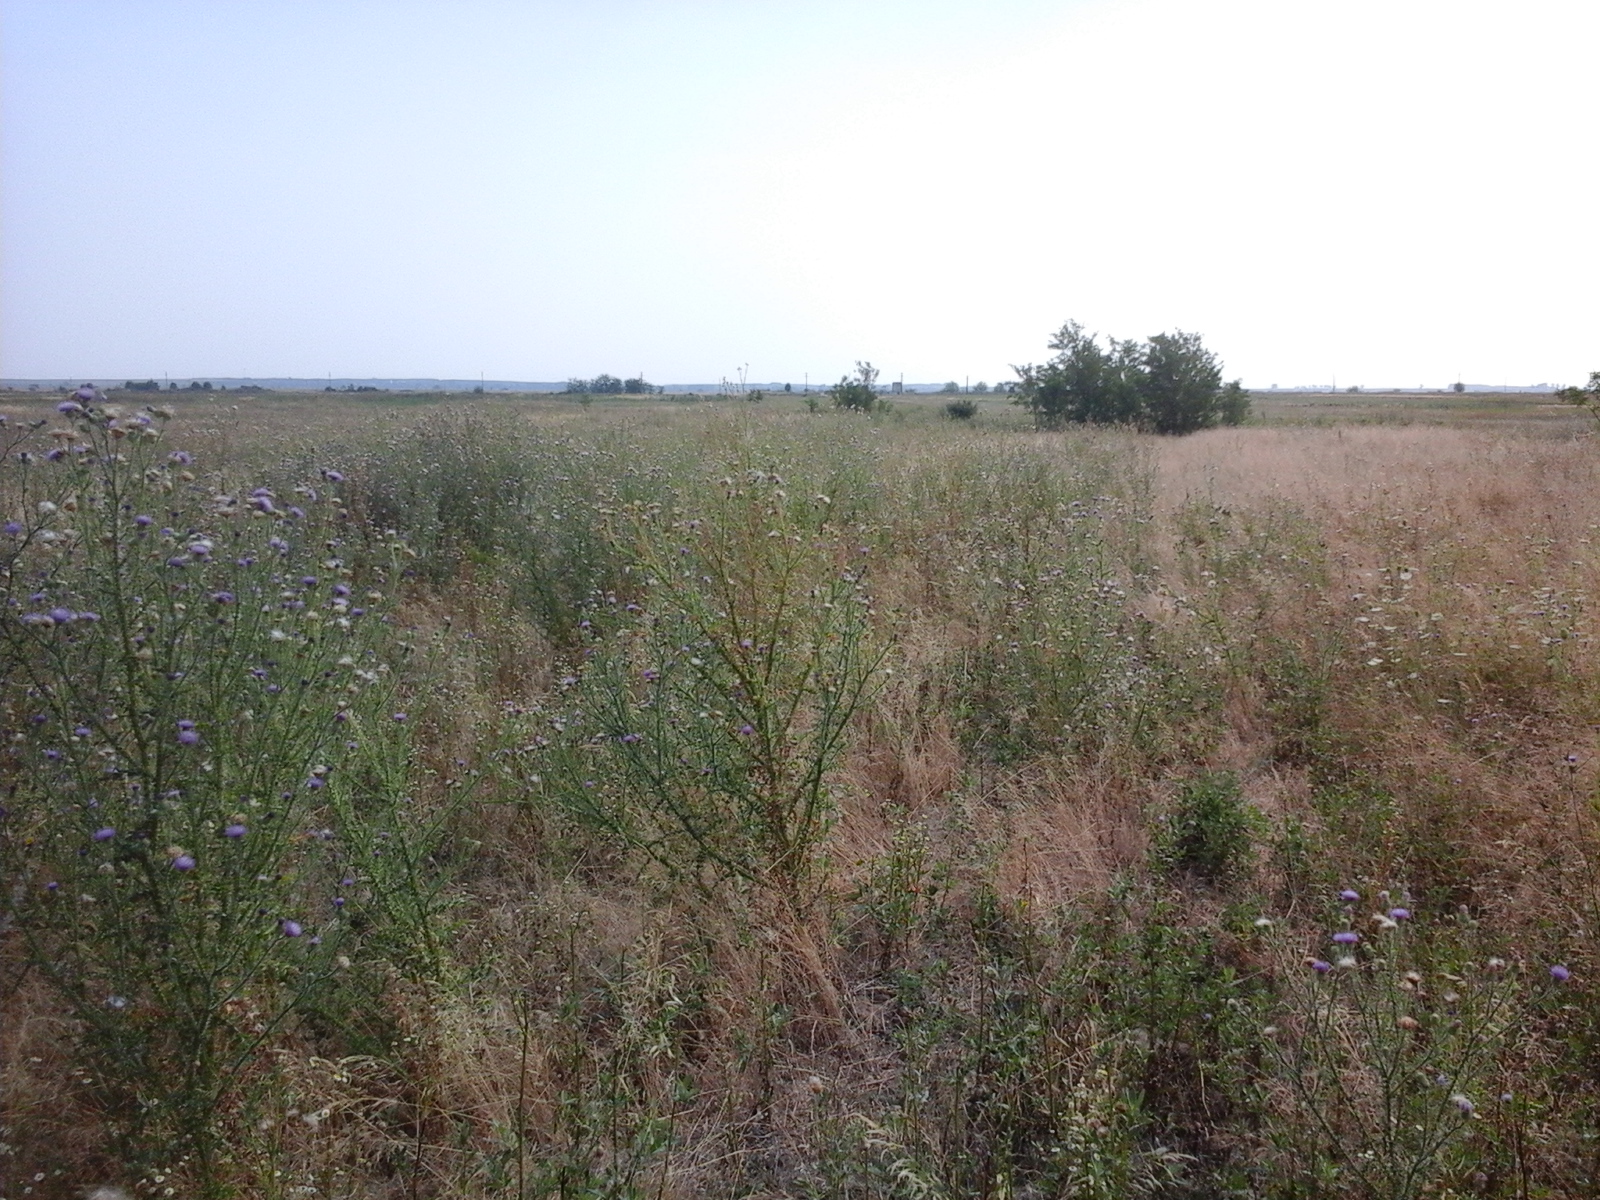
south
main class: Grassland
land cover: Spontaneously vegetated surfaces
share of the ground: > 75 %
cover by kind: herbaceous plants 100 %
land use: Agriculture (excluding fallow land and kitchen gardens)
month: August
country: RO
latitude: 44.4607
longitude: 22.6973
